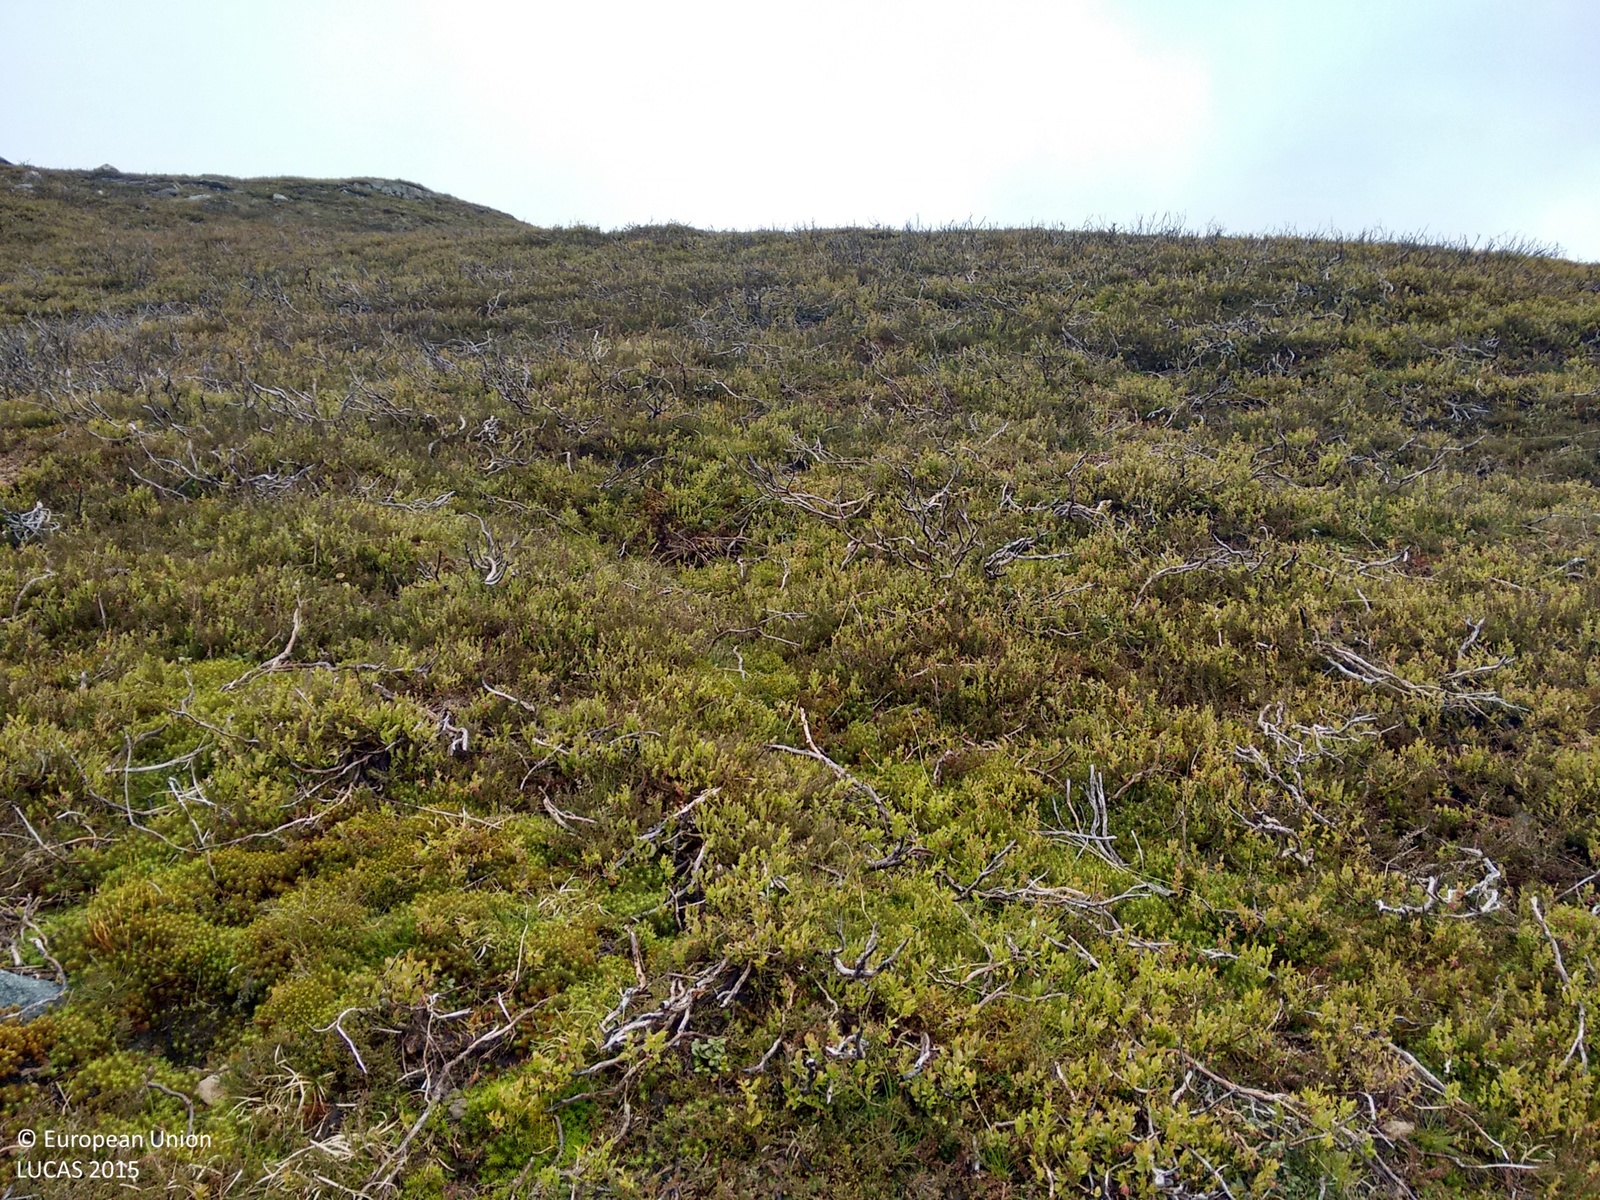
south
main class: Shrubland
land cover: Shrubland without tree cover
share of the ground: > 75 %
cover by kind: shrubs 70 %, herbaceous plants 20 %, lichens and mosses 10 %
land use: Agriculture (excluding fallow land and kitchen gardens)
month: June
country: GB
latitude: 56.4440
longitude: -4.1194
